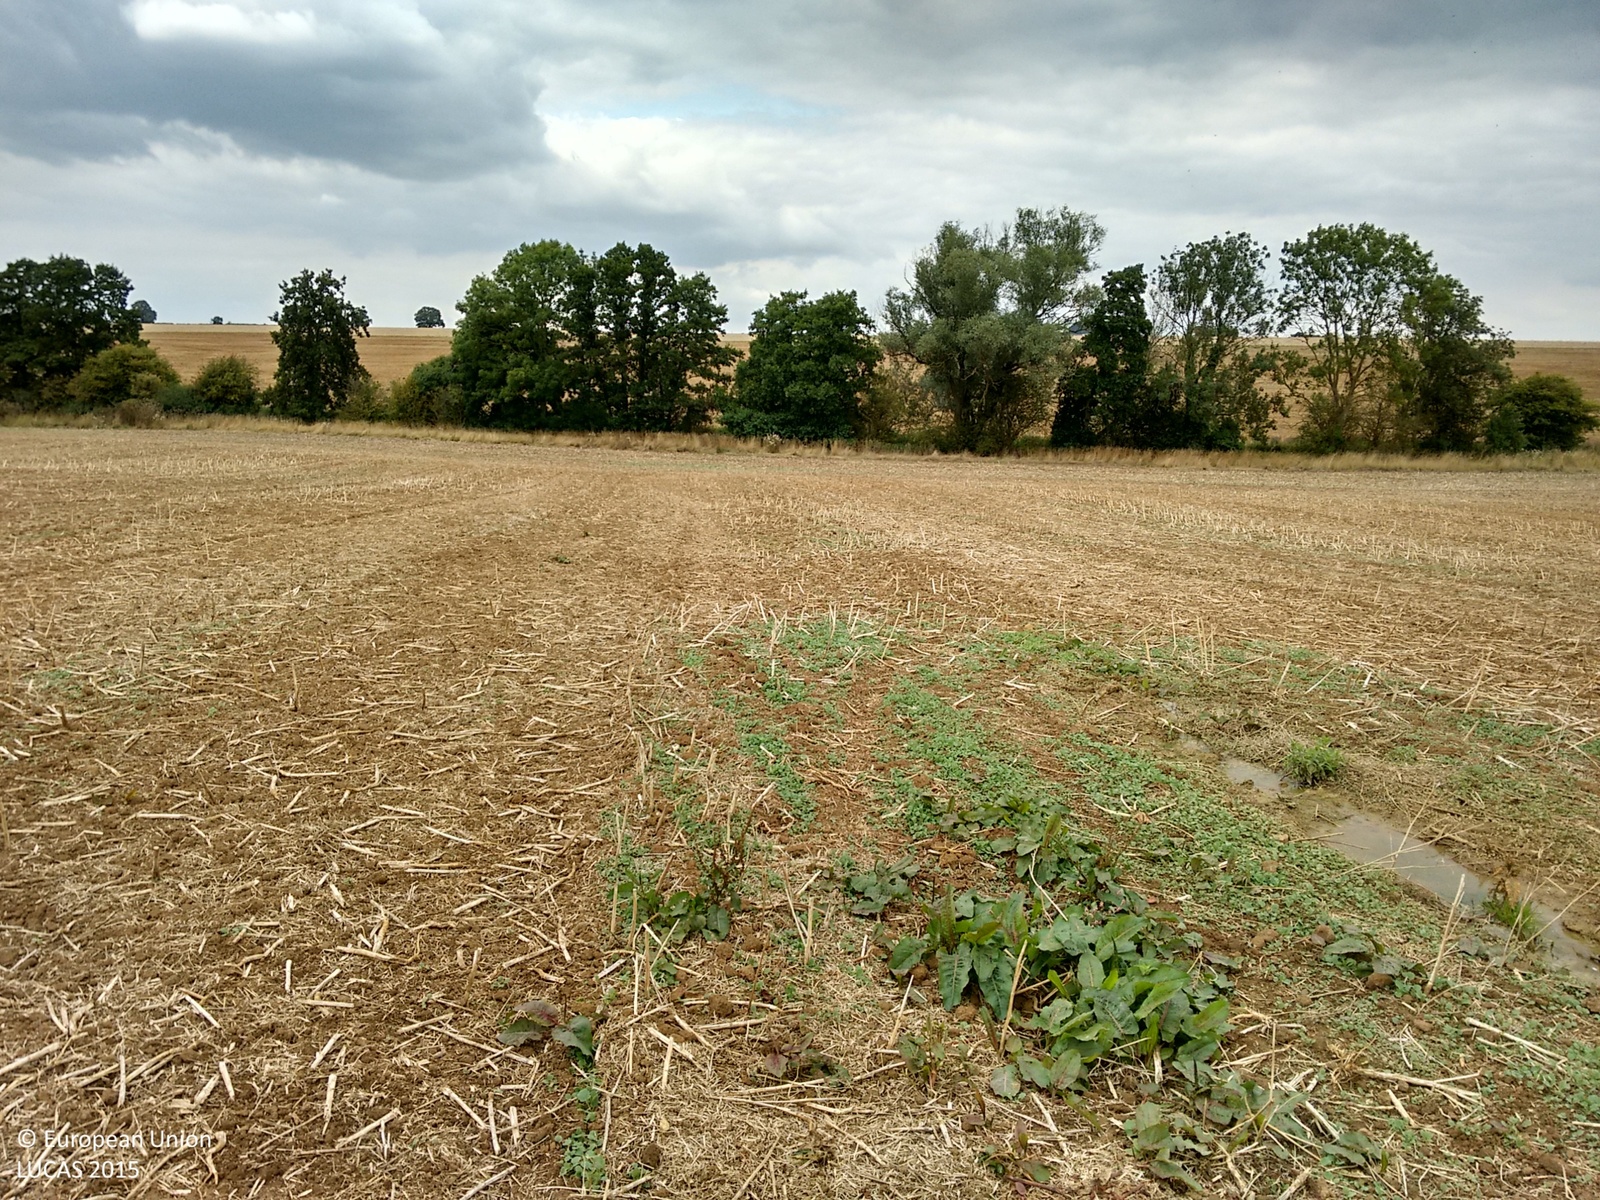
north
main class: Cropland
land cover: Rape and turnip rape
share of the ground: < 10 %
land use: Agriculture (excluding fallow land and kitchen gardens)
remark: Harvested field
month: August
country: GB
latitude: 52.3625
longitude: -0.7167
